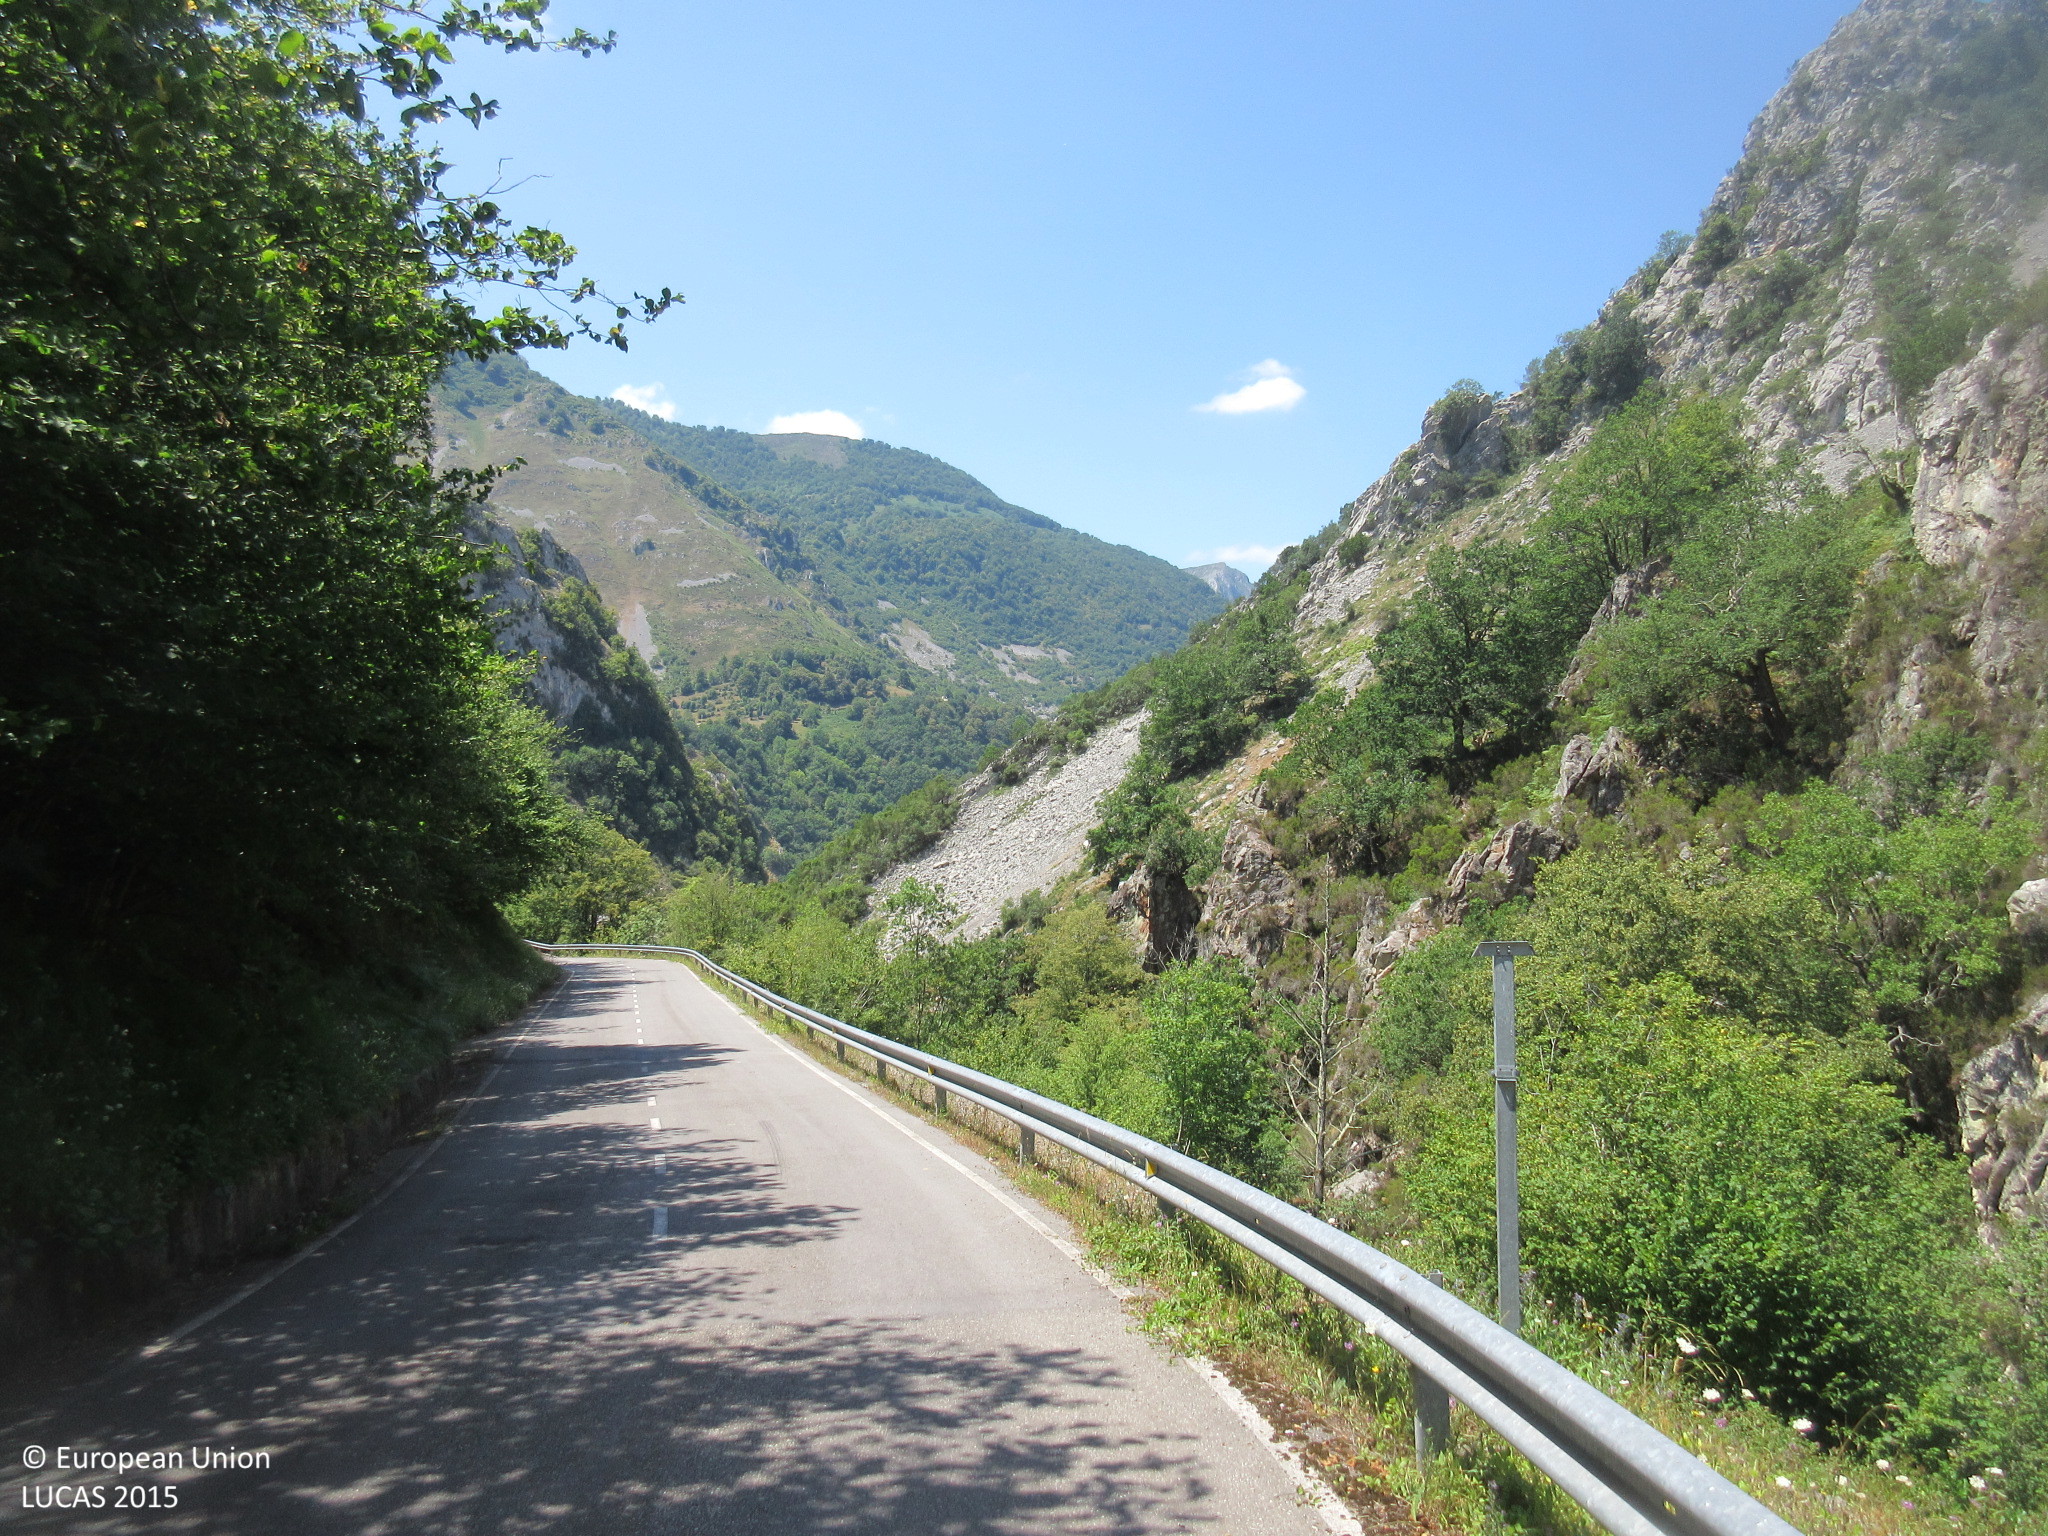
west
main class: Shrubland
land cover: Shrubland without tree cover
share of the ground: 50 - 75 %
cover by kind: shrubs 60 %, consolidated bare surface 40 %
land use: Semi-natural and natural areas not in use
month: July
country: ES
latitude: 43.2407
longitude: -5.0820
